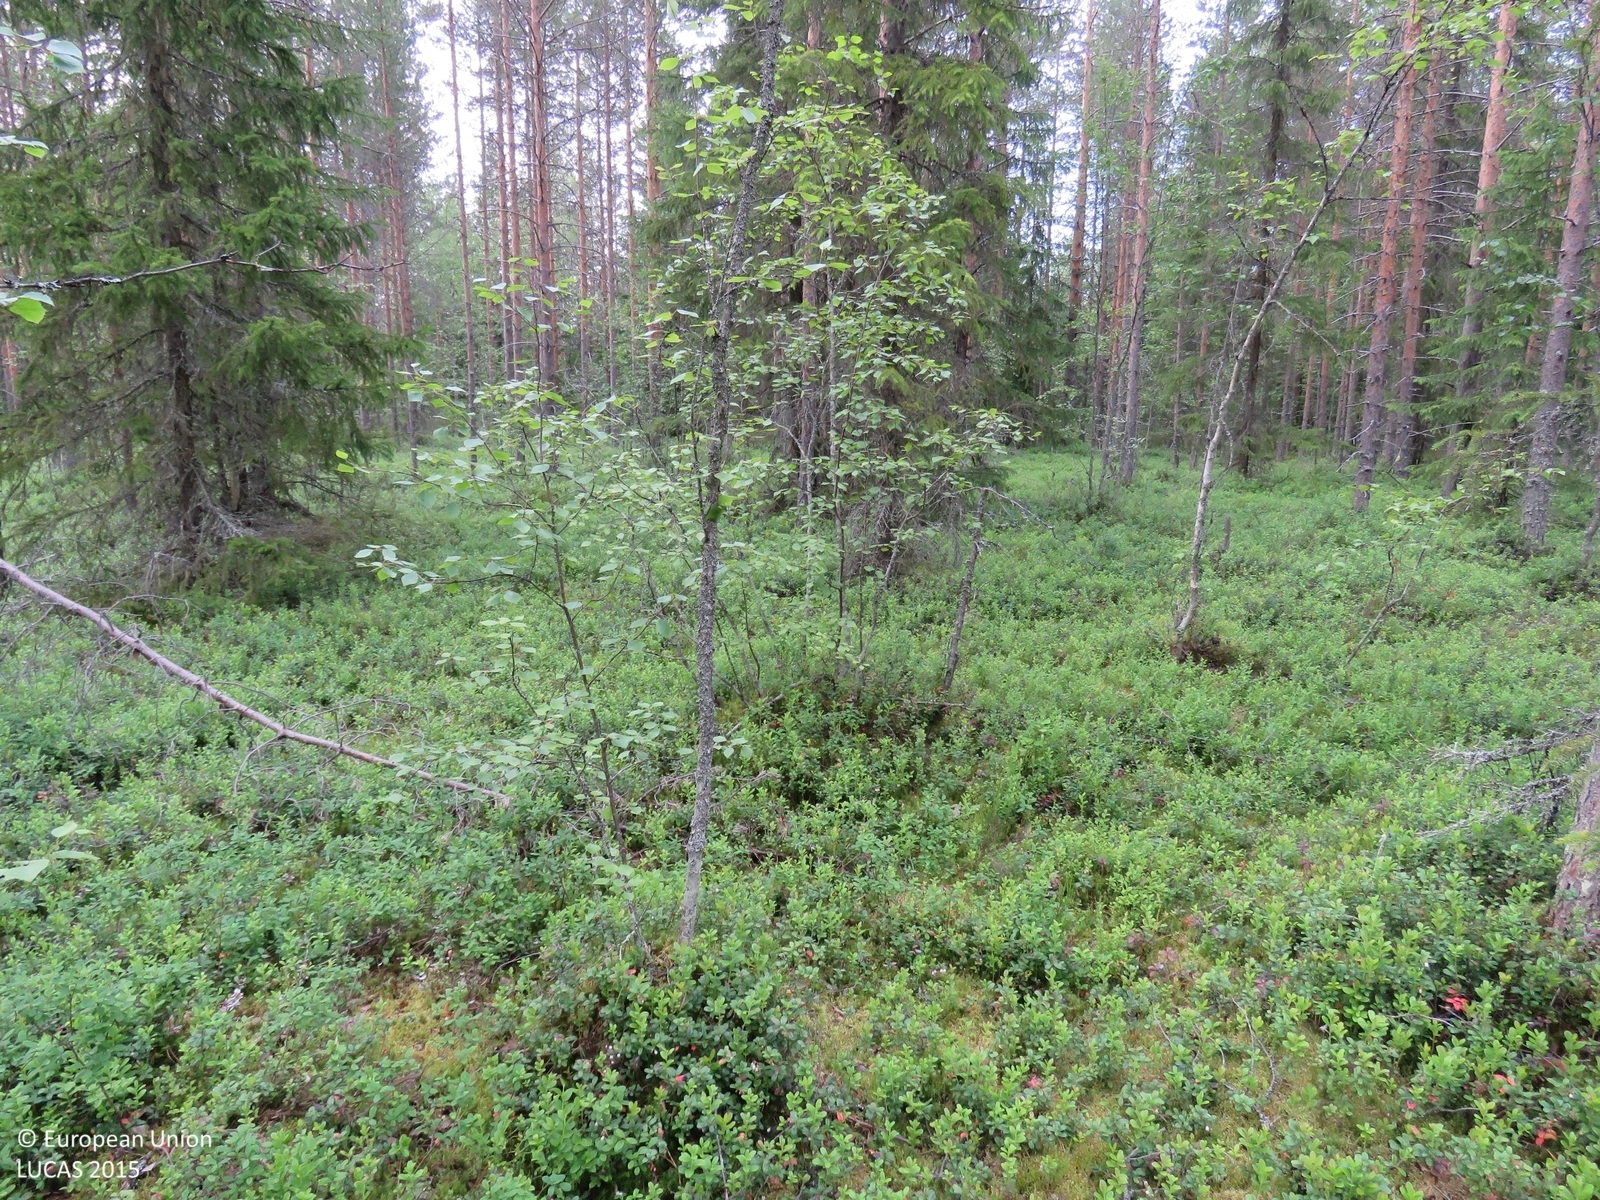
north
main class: Woodland
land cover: Pine dominated coniferous woodland
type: boreal forest
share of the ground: > 75 %
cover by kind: coniferous forest trees 70 %, shrubs 15 %, broadleaved forest trees 10 %, lichens and mosses 5 %
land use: Forestry
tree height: > 5 m
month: July
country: FI
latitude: 64.8283
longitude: 26.0933
